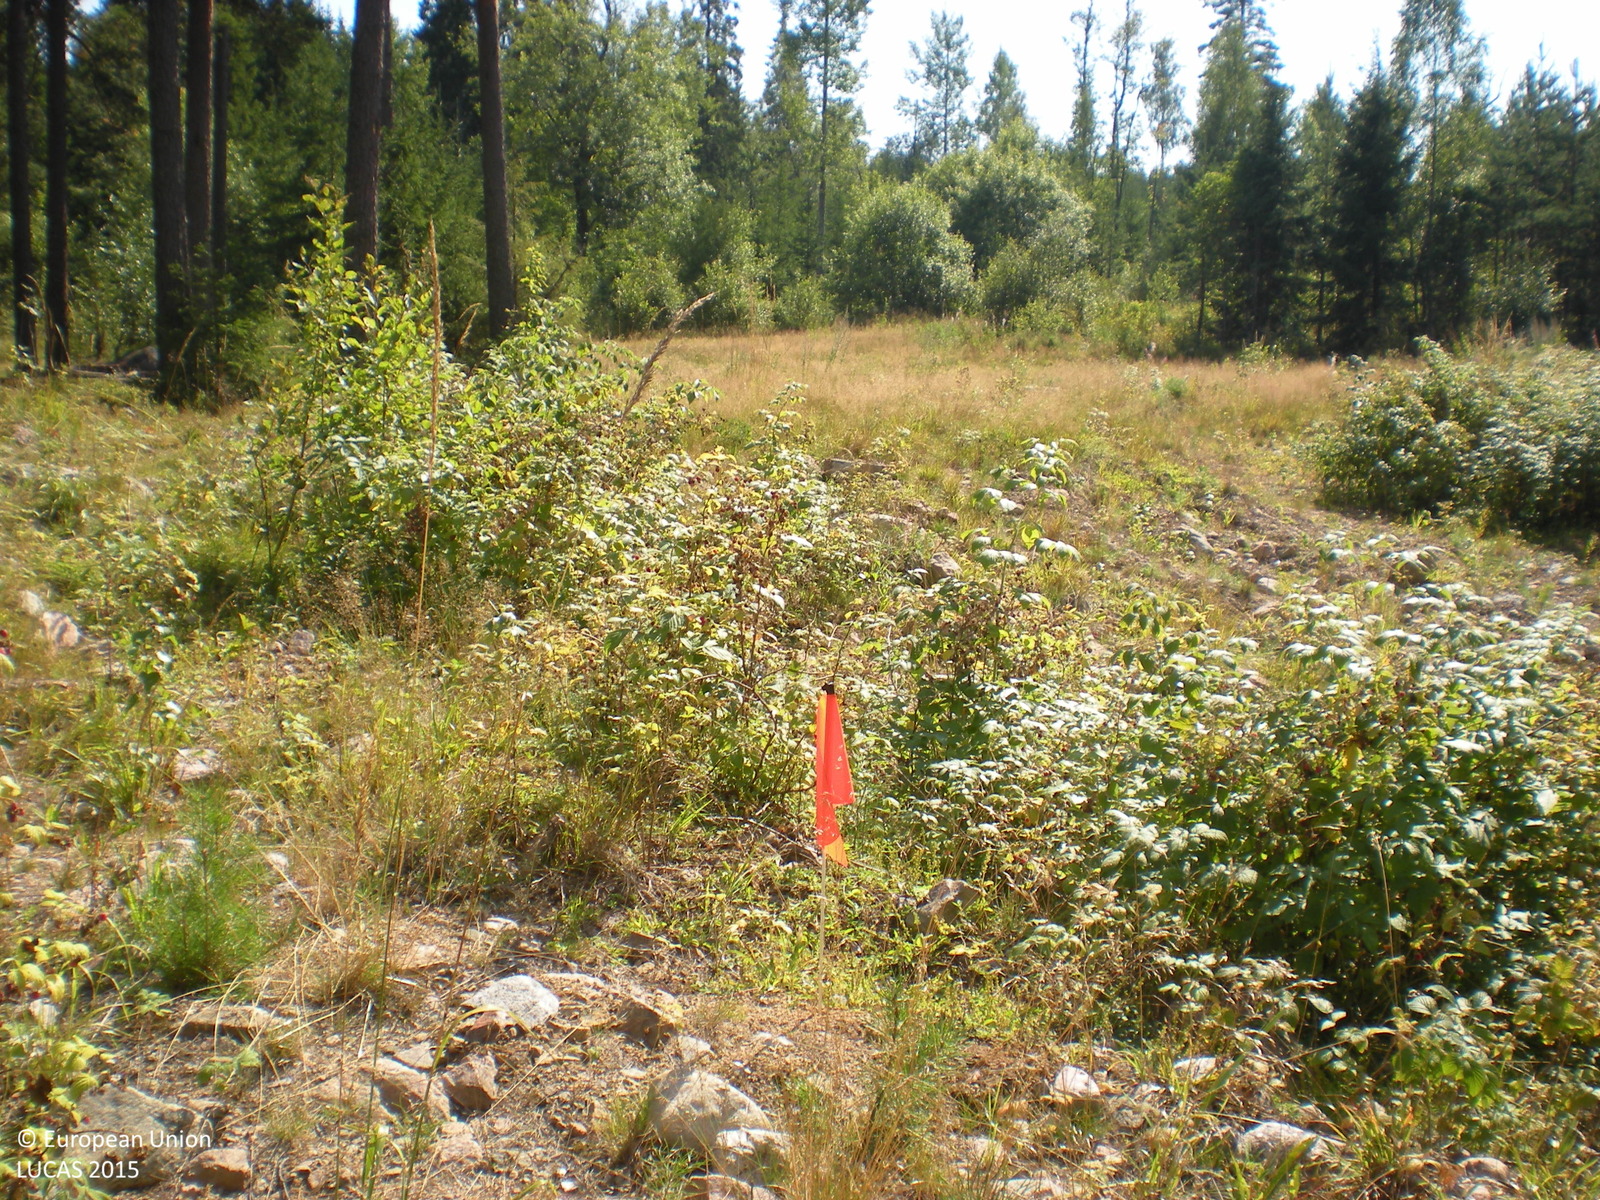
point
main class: Shrubland
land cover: Shrubland with sparse tree cover
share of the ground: 50 - 75 %
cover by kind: shrubs 60 %, unconsolidated bare surface 15 %, herbaceous plants 10 %, consolidated bare surface 10 %, broadleaved forest trees 5 %
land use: Forestry
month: August
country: SE
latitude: 60.6257
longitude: 17.2819
